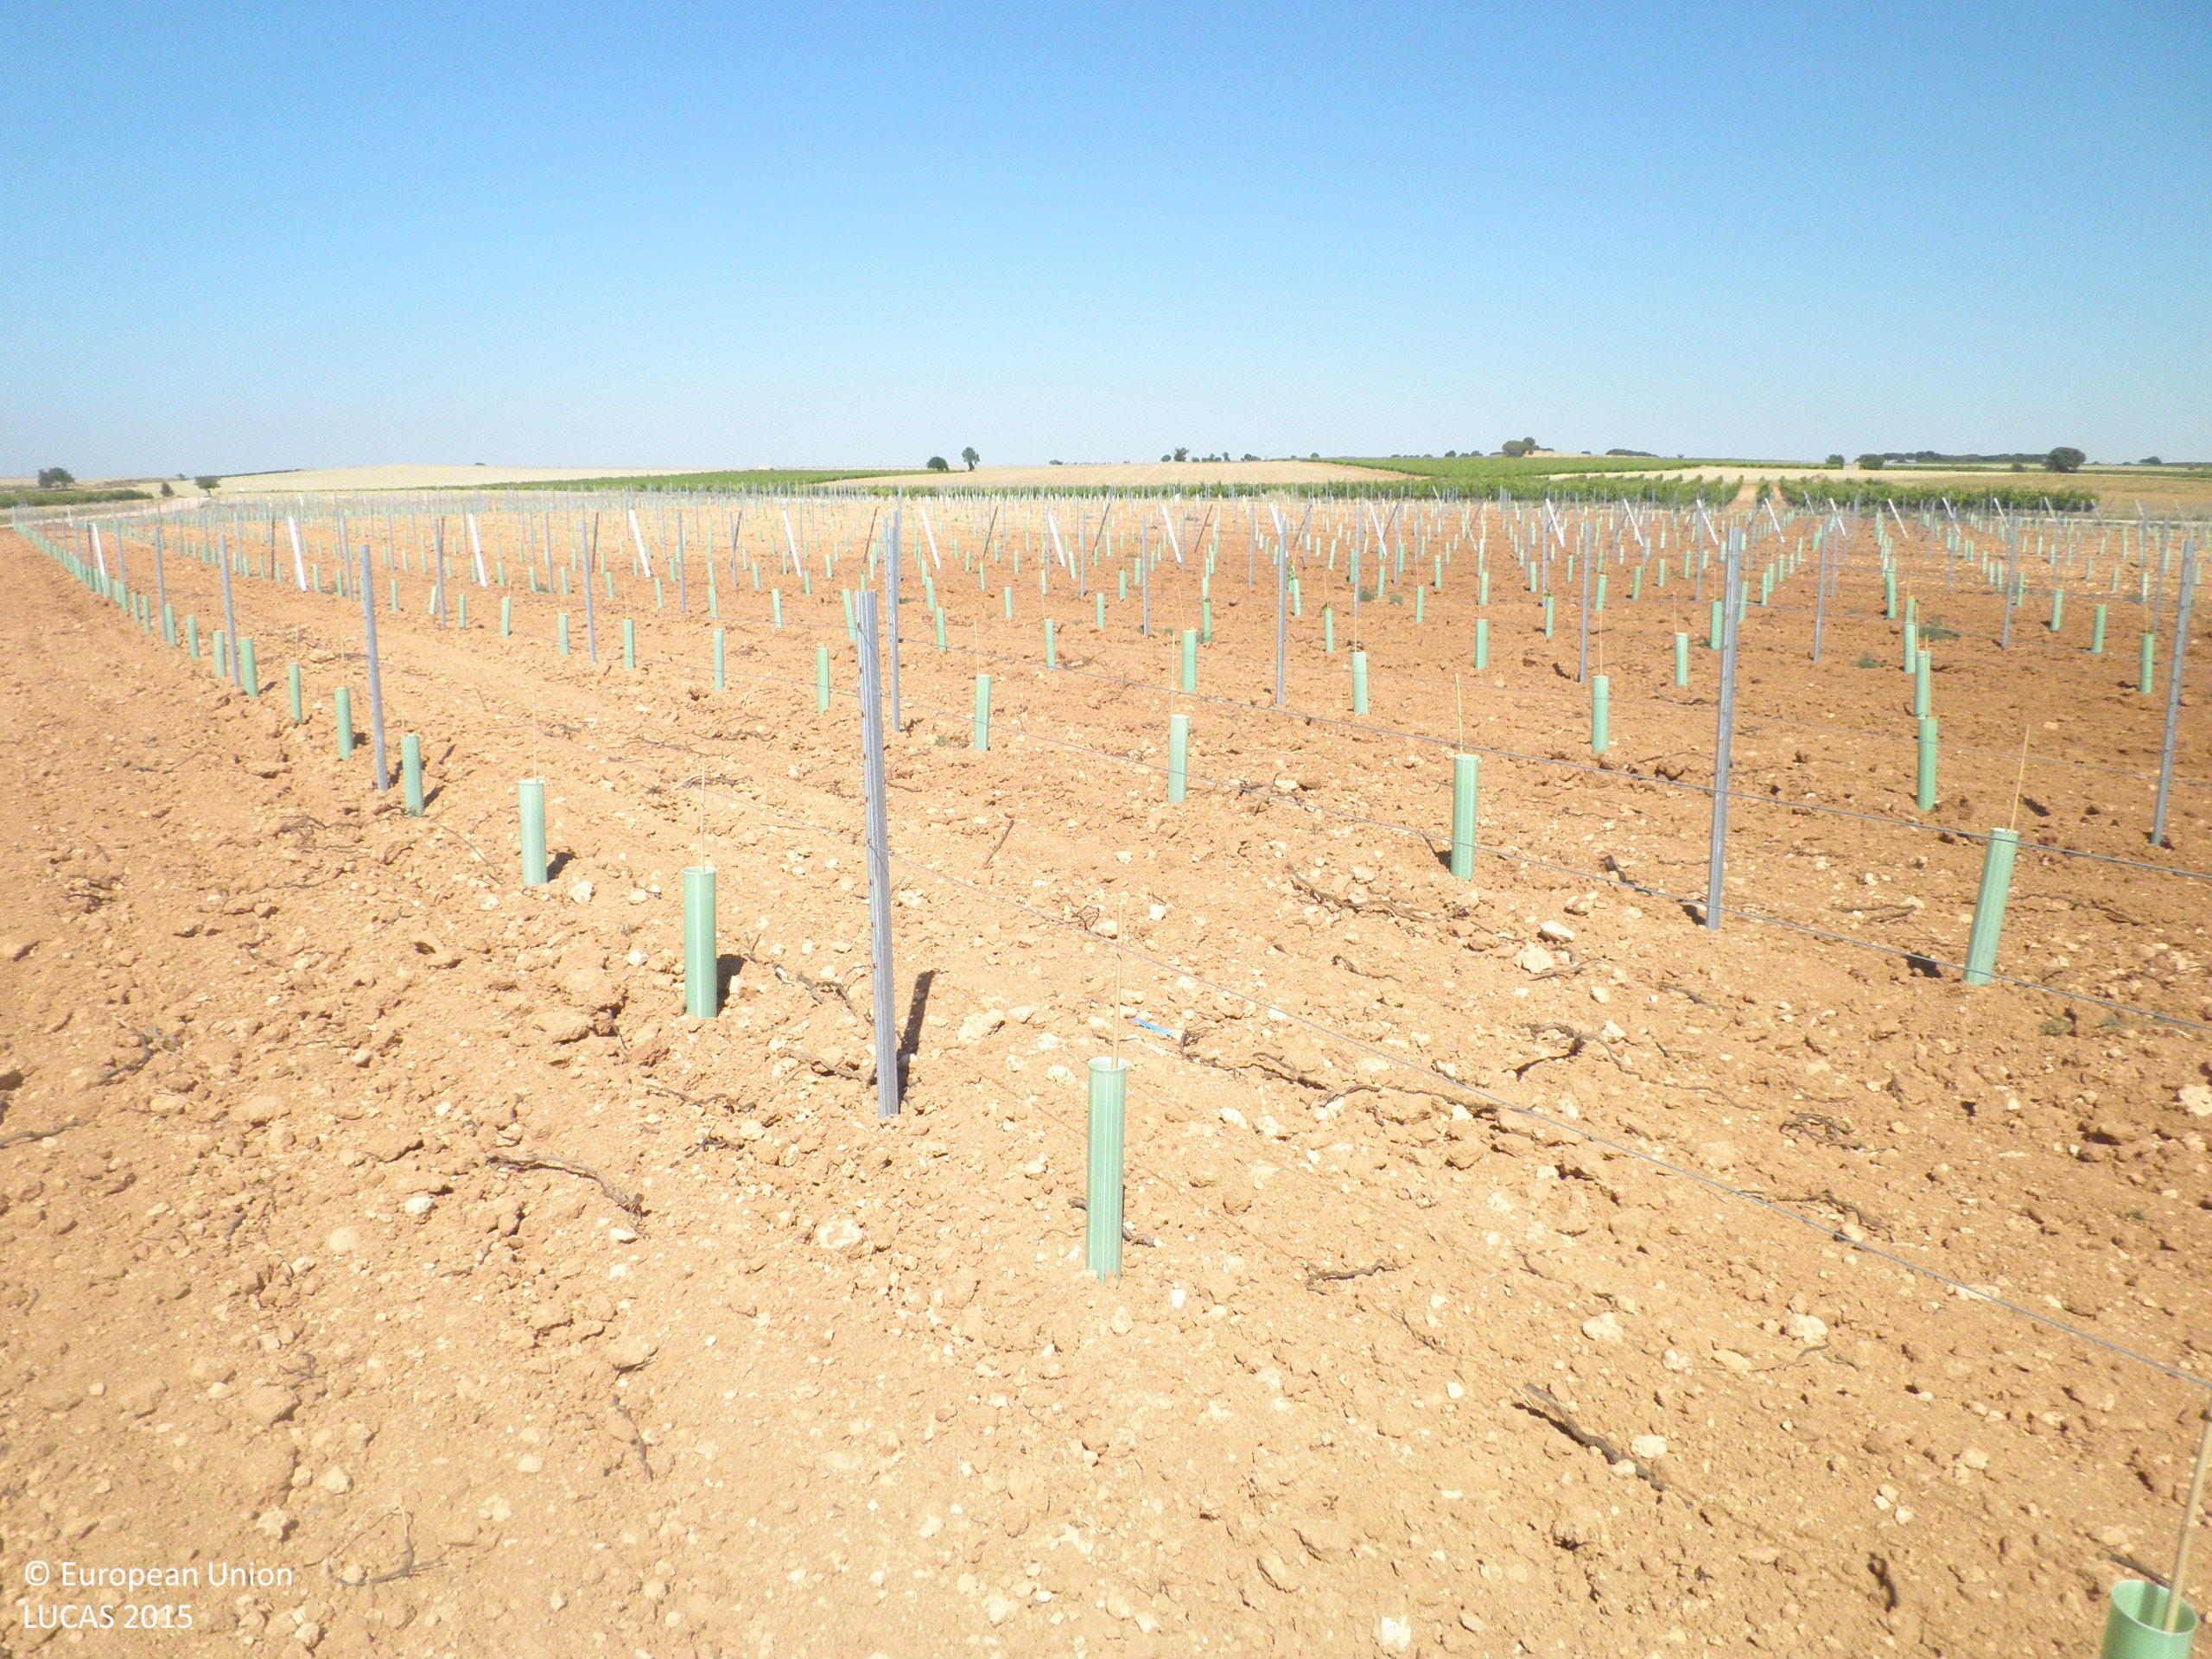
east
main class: Cropland
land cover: Vineyards
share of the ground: < 10 %
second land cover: Other bare soil
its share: > 75 %
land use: Agriculture (excluding fallow land and kitchen gardens)
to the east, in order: Vineyards; Other bare soil; Grass margins; Tracks; Vineyards
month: June
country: ES
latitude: 39.4280
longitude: -1.7731
